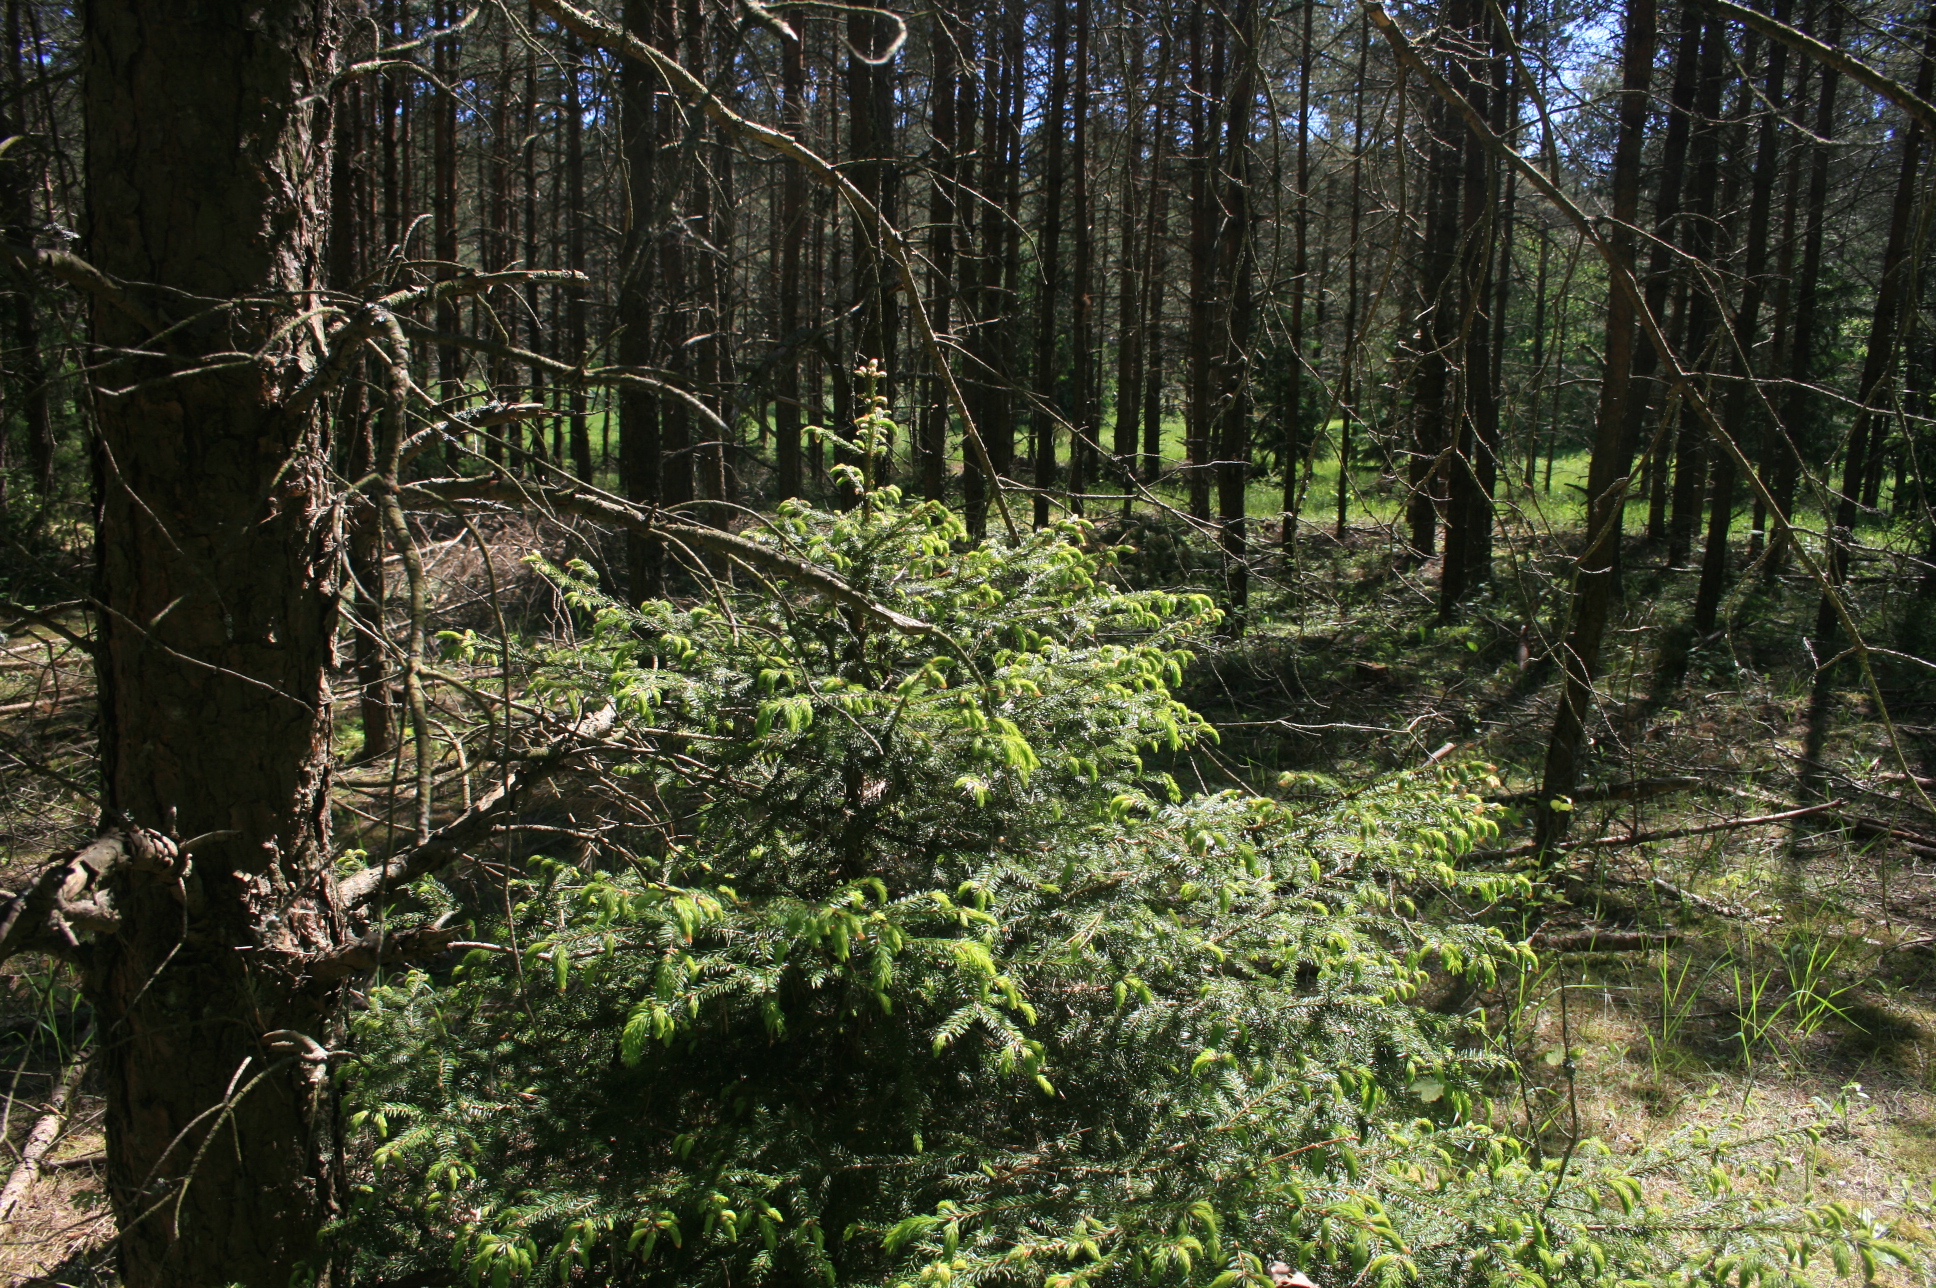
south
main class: Woodland
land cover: Pine dominated coniferous woodland
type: hemiboreal forest and nemoral coniferous forest and mixed broadleaved-coniferous forest
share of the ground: > 75 %
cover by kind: coniferous forest trees 85 %, broadleaved forest trees 5 %, herbaceous plants 5 %, lichens and mosses 5 %
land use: Forestry
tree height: > 5 m
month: June
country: LT
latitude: 55.5118
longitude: 22.2019
